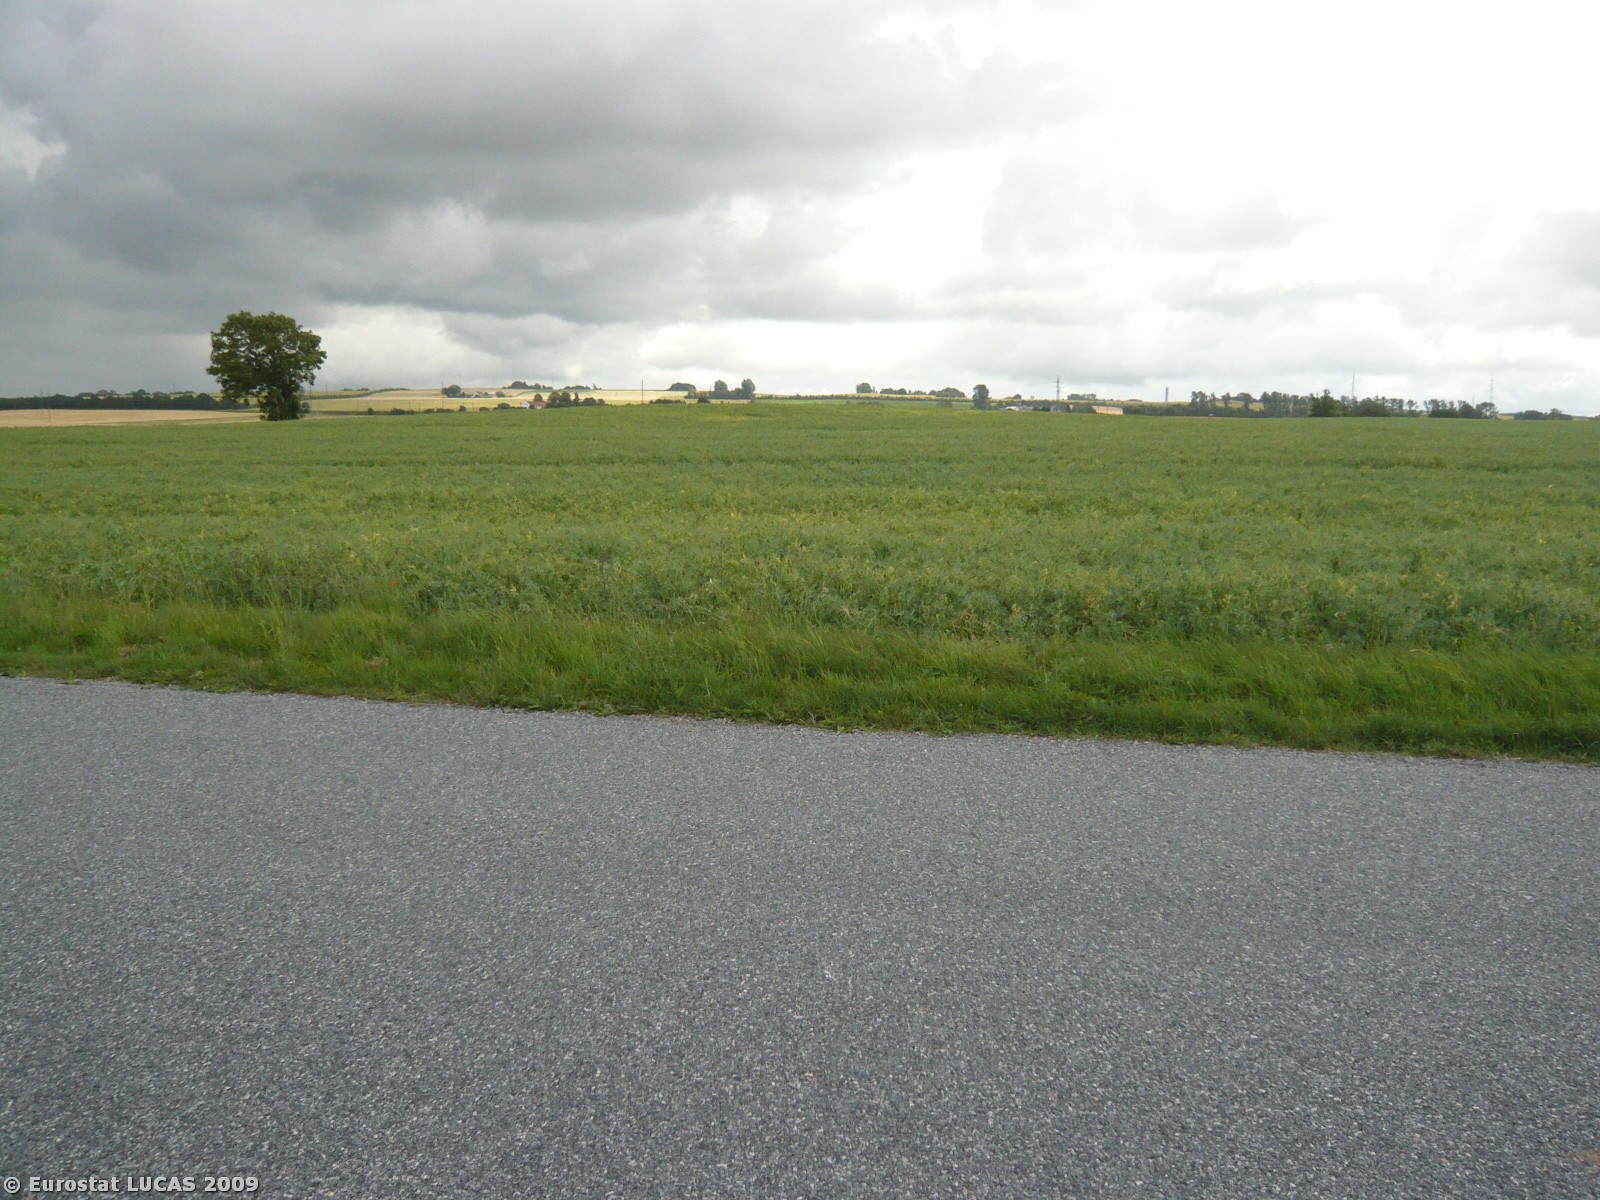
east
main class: Cropland
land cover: Barley
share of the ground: > 75 %
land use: Agriculture (excluding fallow land and kitchen gardens)
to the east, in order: Barley; Grass margins; Paved roads, cycling and walking lanes; Grass margins; Other fresh vegetables
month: July
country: DK
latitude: 55.3904
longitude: 11.2776
